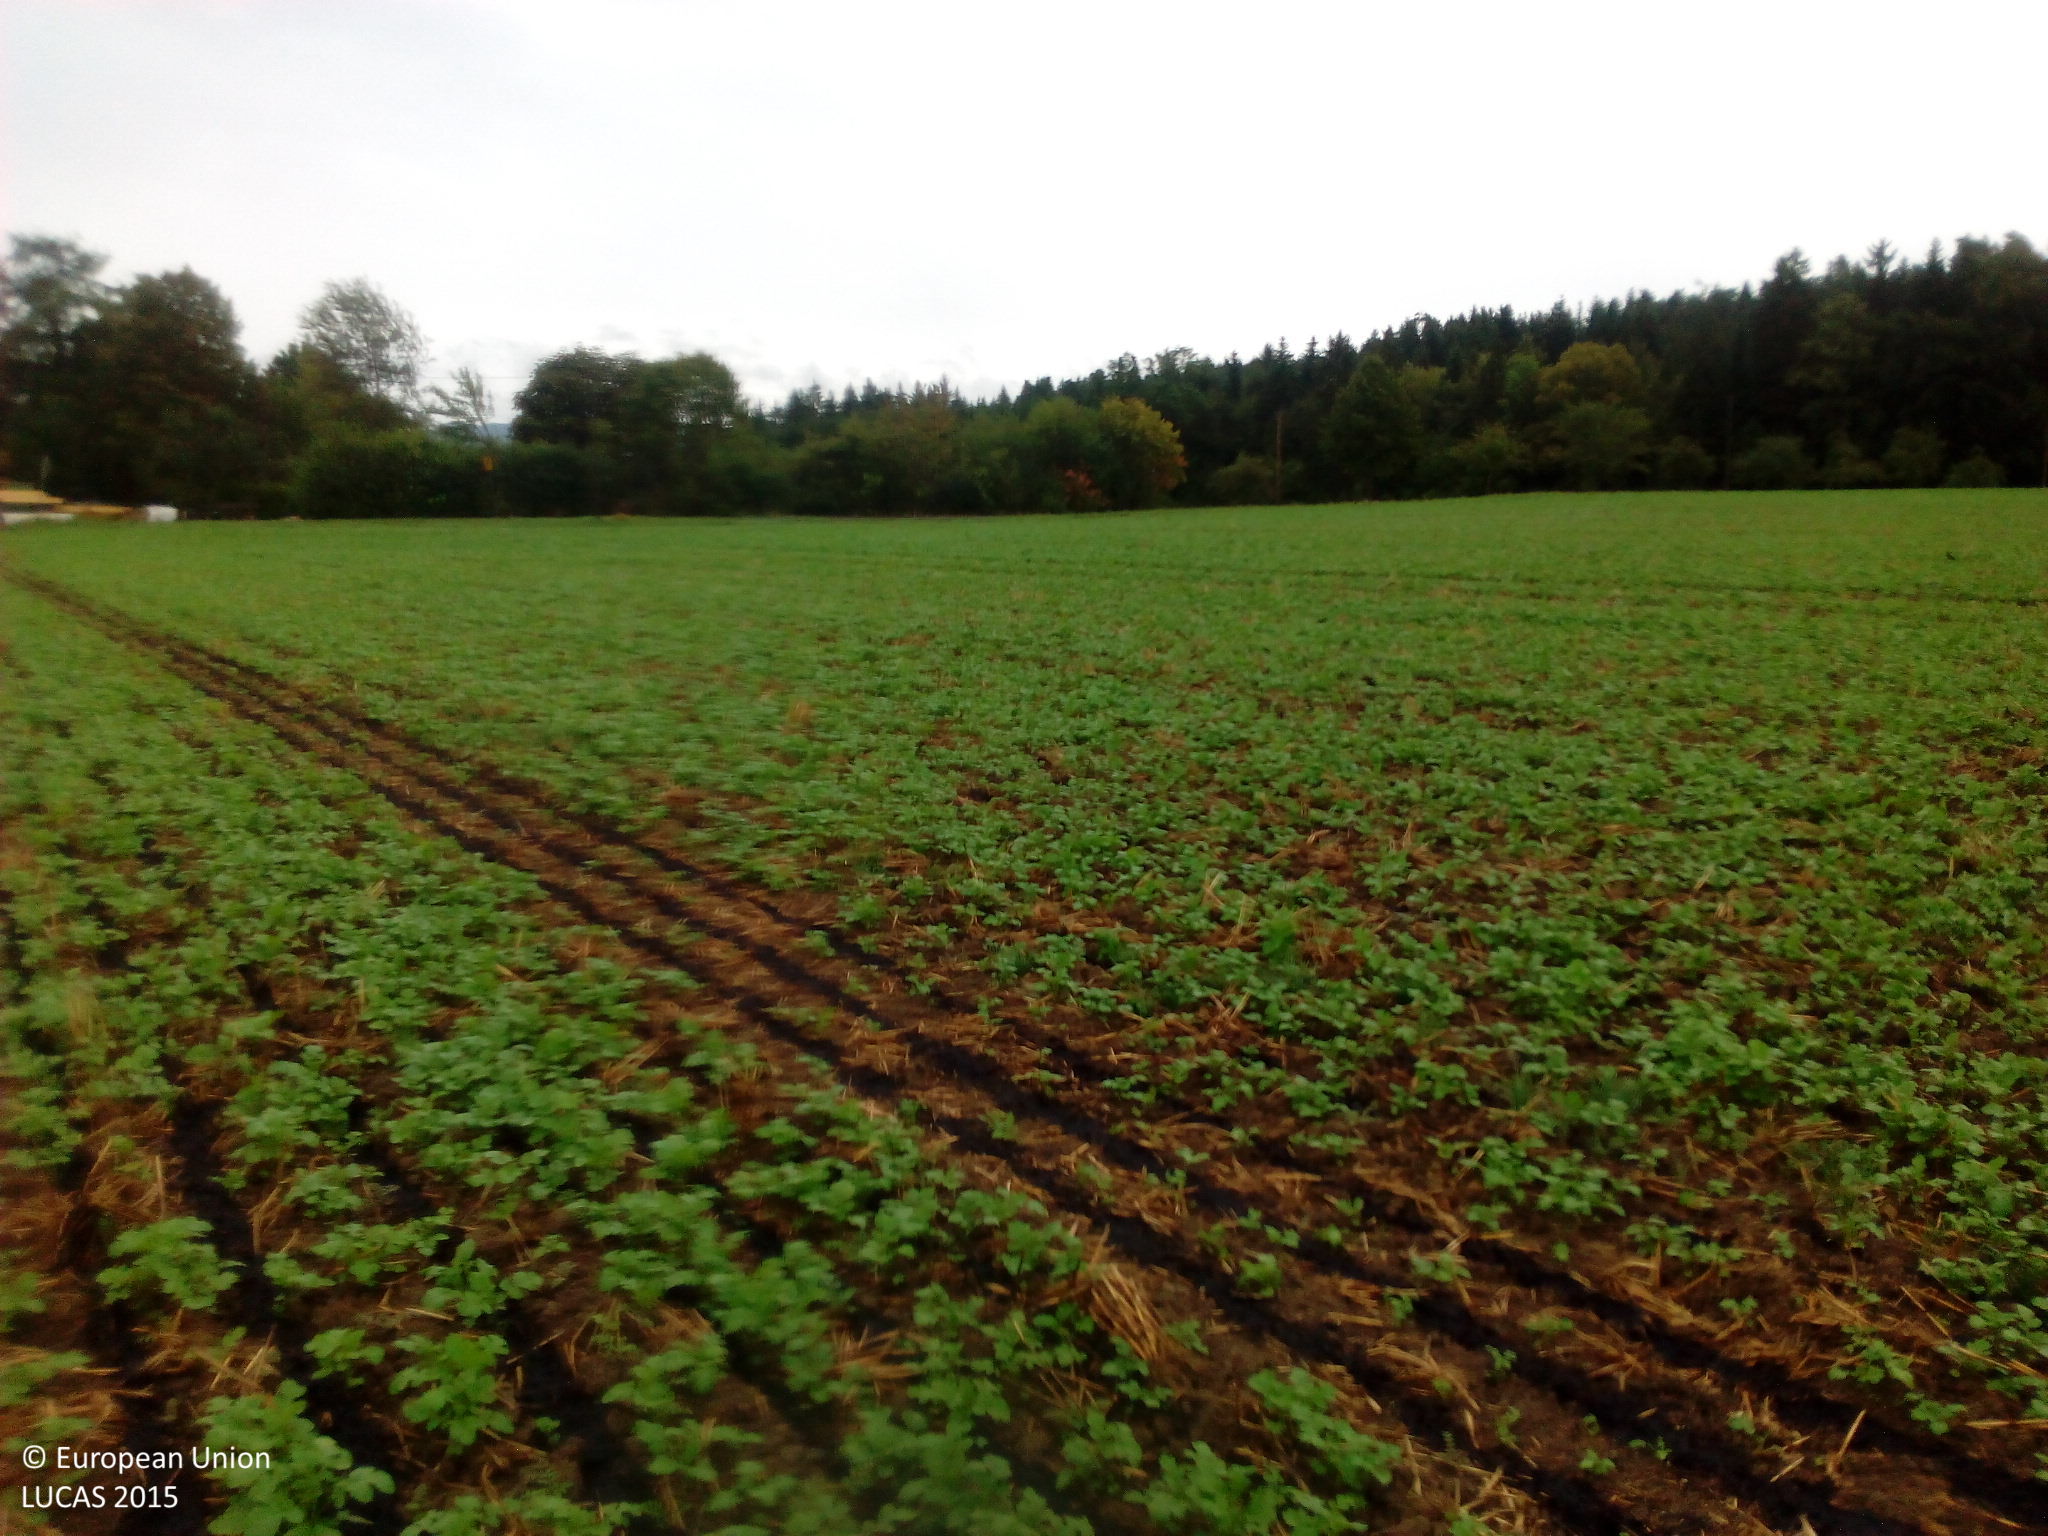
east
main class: Cropland
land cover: Other fibre and oleaginous crops
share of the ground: 50 - 75 %
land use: Agriculture (excluding fallow land and kitchen gardens)
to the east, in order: Other fibre and oleaginous crops; Electric lines; Grass margins; Paved roads, cycling and walking lanes; Grass margins; Broadleaved woodland; Grassland without tree/shrub cover; Single bushes/trees; Grassland without tree/shrub cover
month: September
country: DE
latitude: 48.1425
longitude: 8.5897
